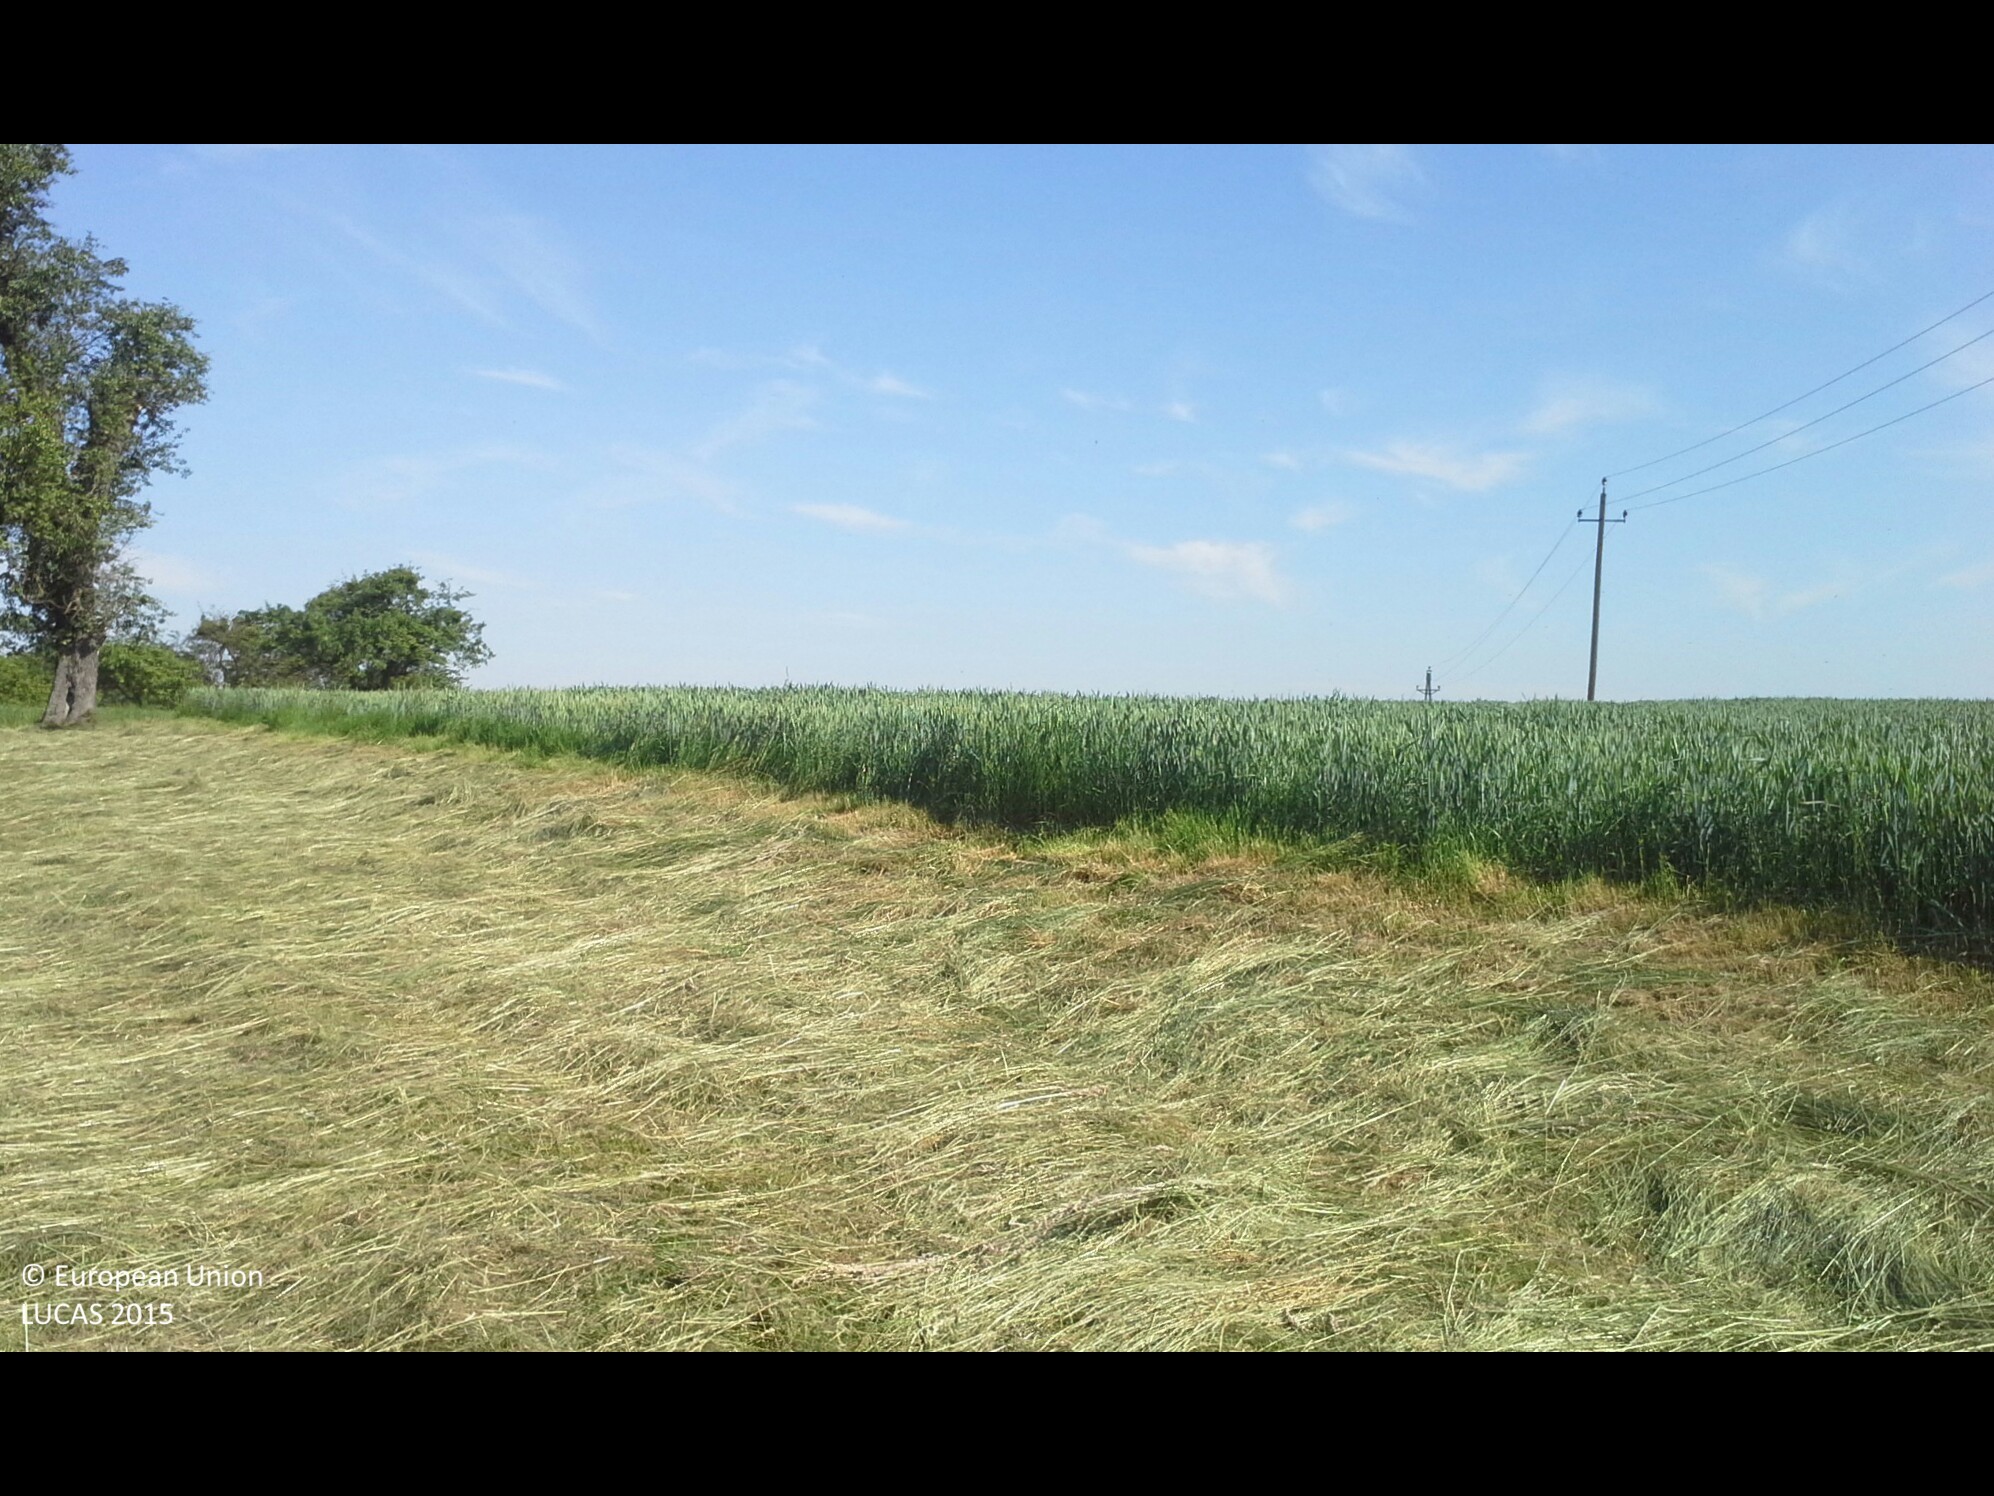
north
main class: Cropland
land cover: Common wheat
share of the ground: > 75 %
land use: Agriculture (excluding fallow land and kitchen gardens)
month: June
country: AT
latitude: 48.1642
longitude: 14.5852
